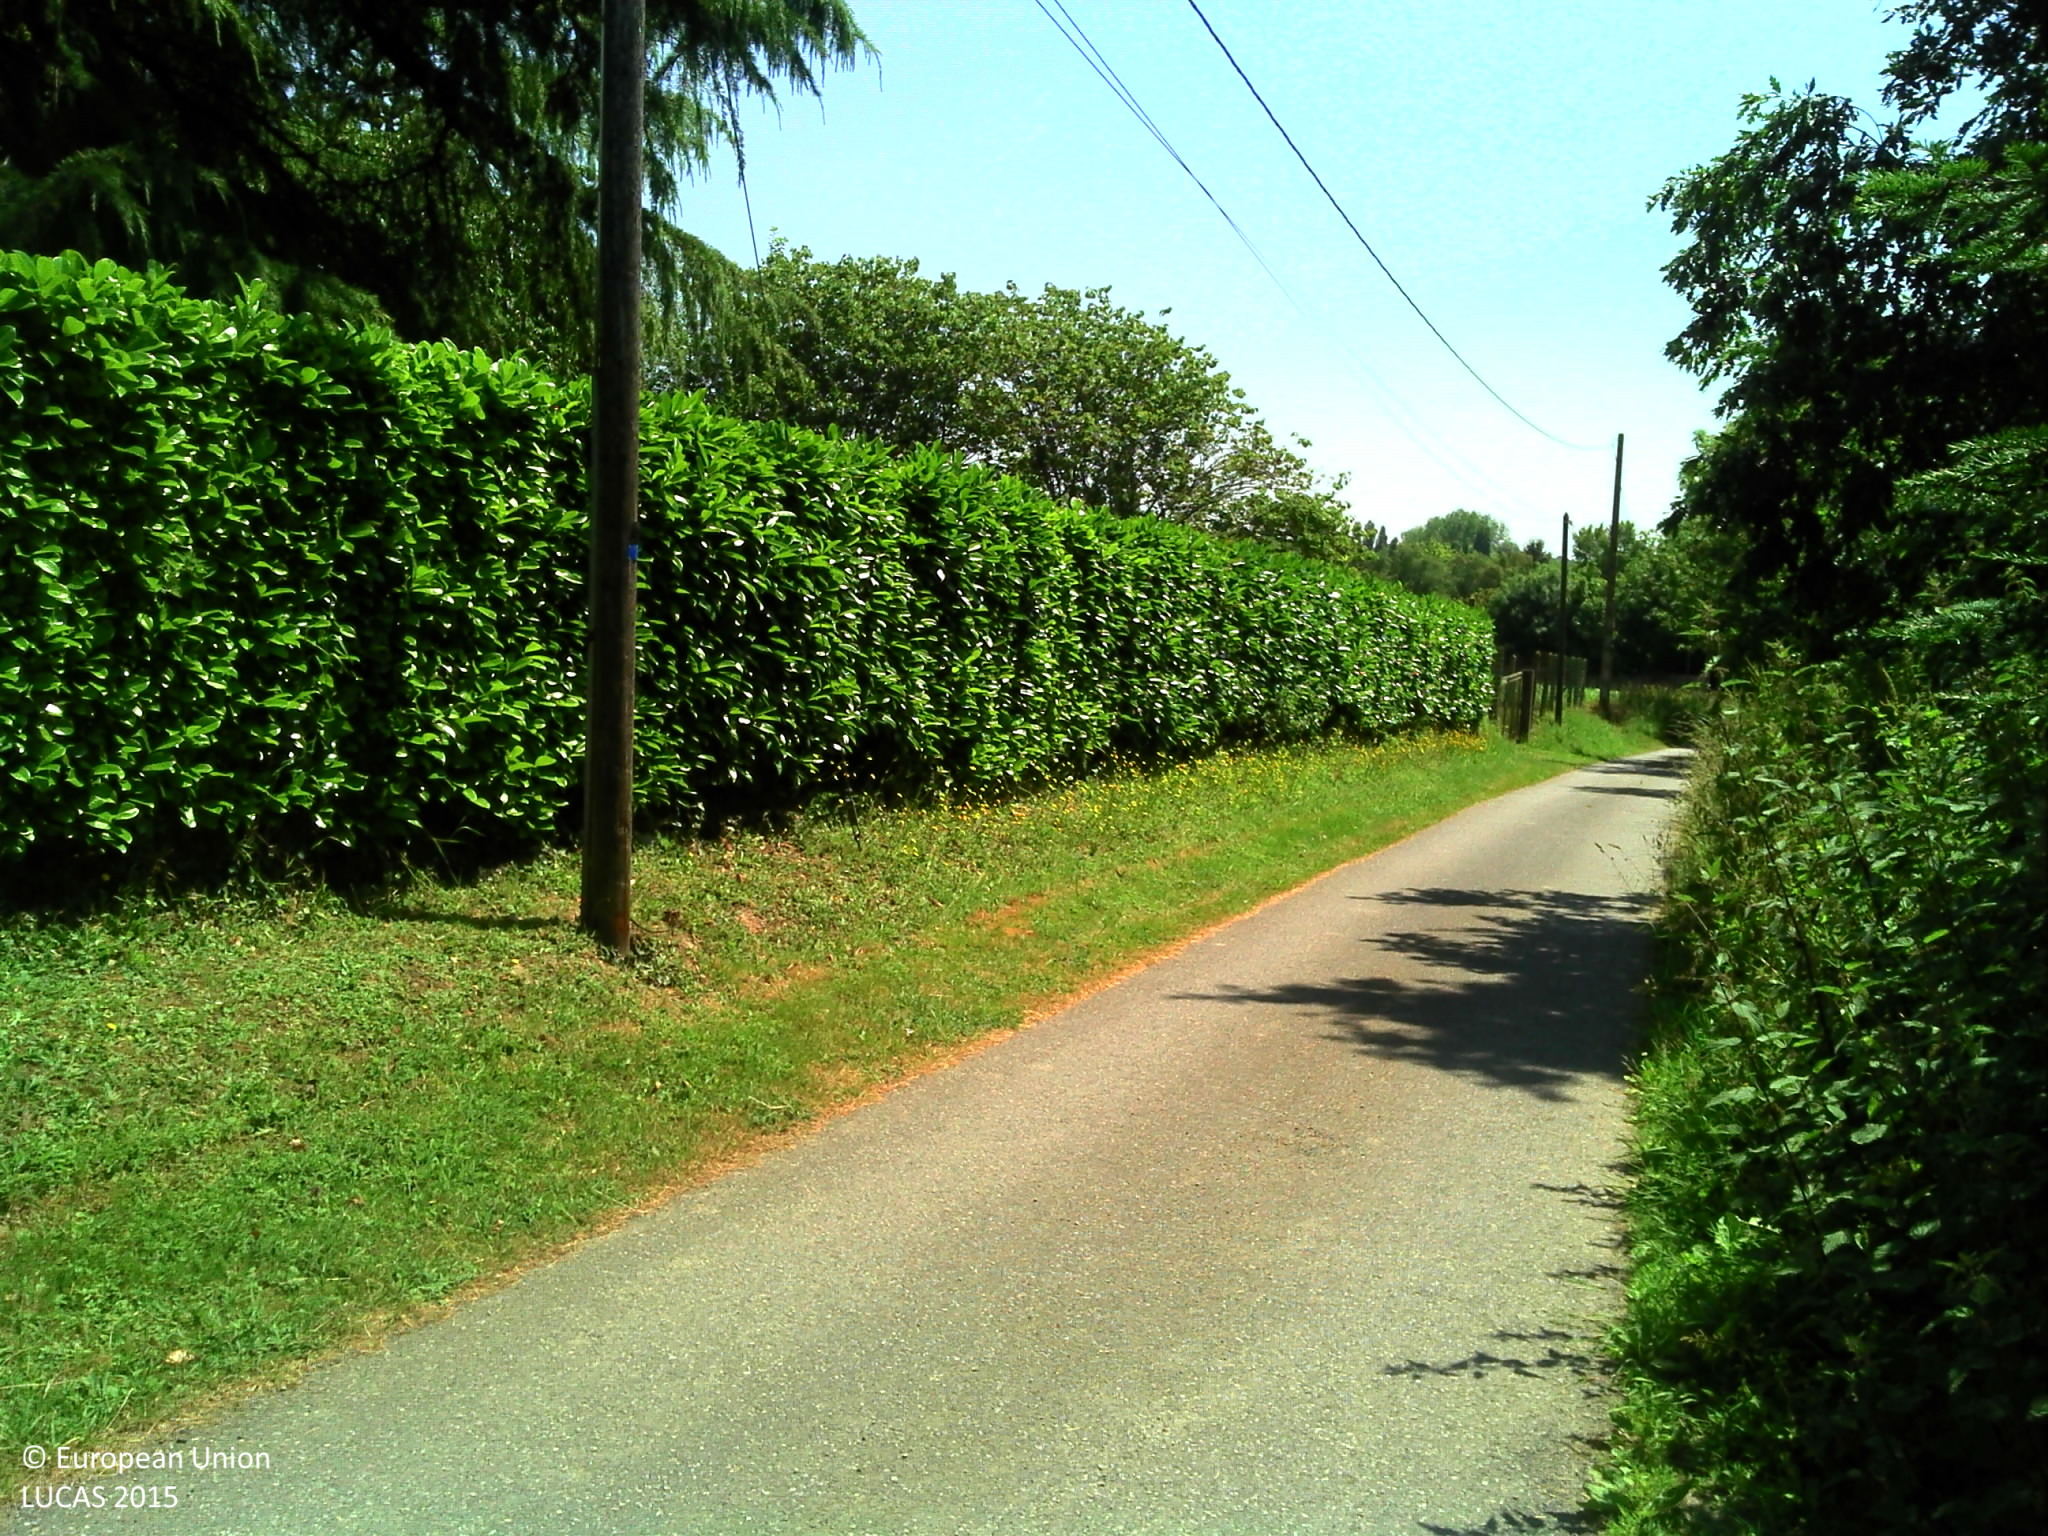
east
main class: Grassland
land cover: Grassland with sparse tree/shrub cover
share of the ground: > 75 %
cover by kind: herbaceous plants 95 %, broadleaved forest trees 5 %
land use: Residential
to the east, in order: Grassland with sparse tree/shrub cover; Artificial constructions in urban areas; Grass margins; Paved roads, cycling and walking lanes; Maize; Dry stone walls; Artificial constructions in urban areas; Abandoned hedges; Grassland without tree/shrub cover
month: June
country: FR
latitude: 48.0427
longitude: -1.6229
